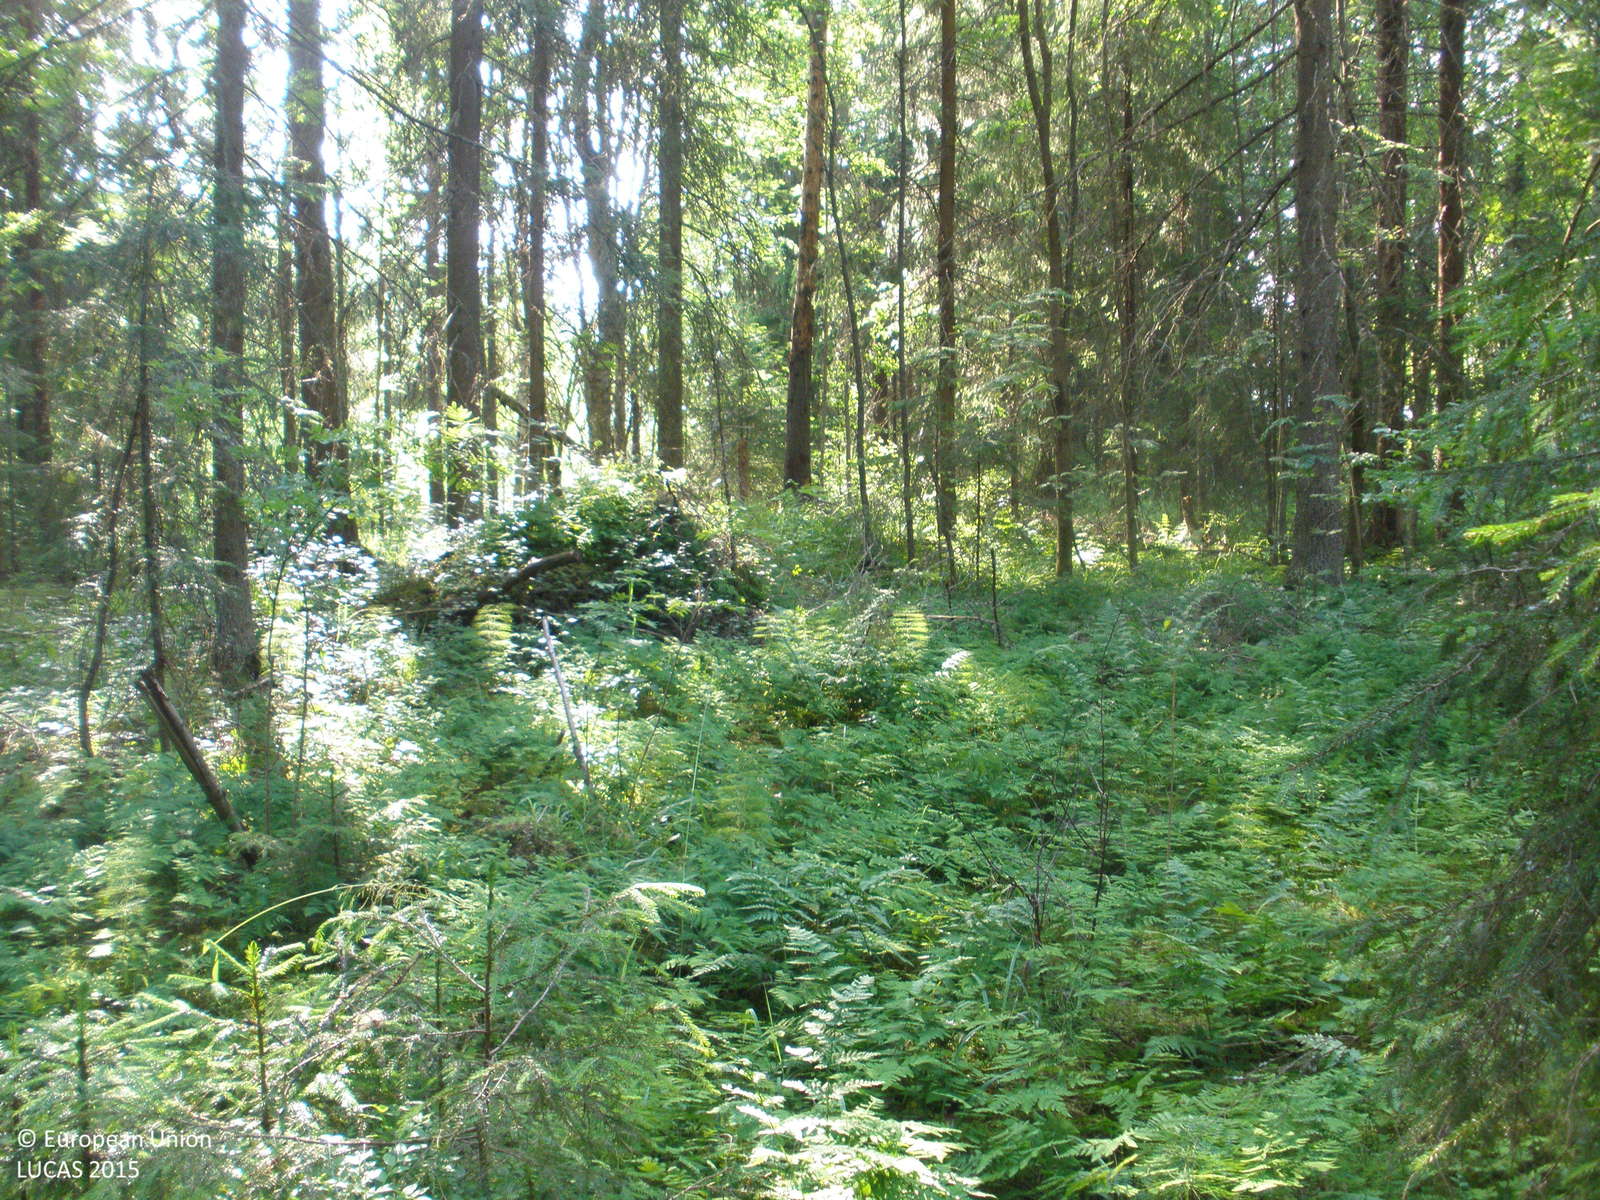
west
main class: Woodland
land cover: Spruce dominated coniferous woodland
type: boreal forest
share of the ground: > 75 %
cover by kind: coniferous forest trees 85 %, lichens and mosses 10 %, herbaceous plants 5 %
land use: Forestry
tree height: > 5 m
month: July
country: FI
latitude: 61.4168
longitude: 23.8580
